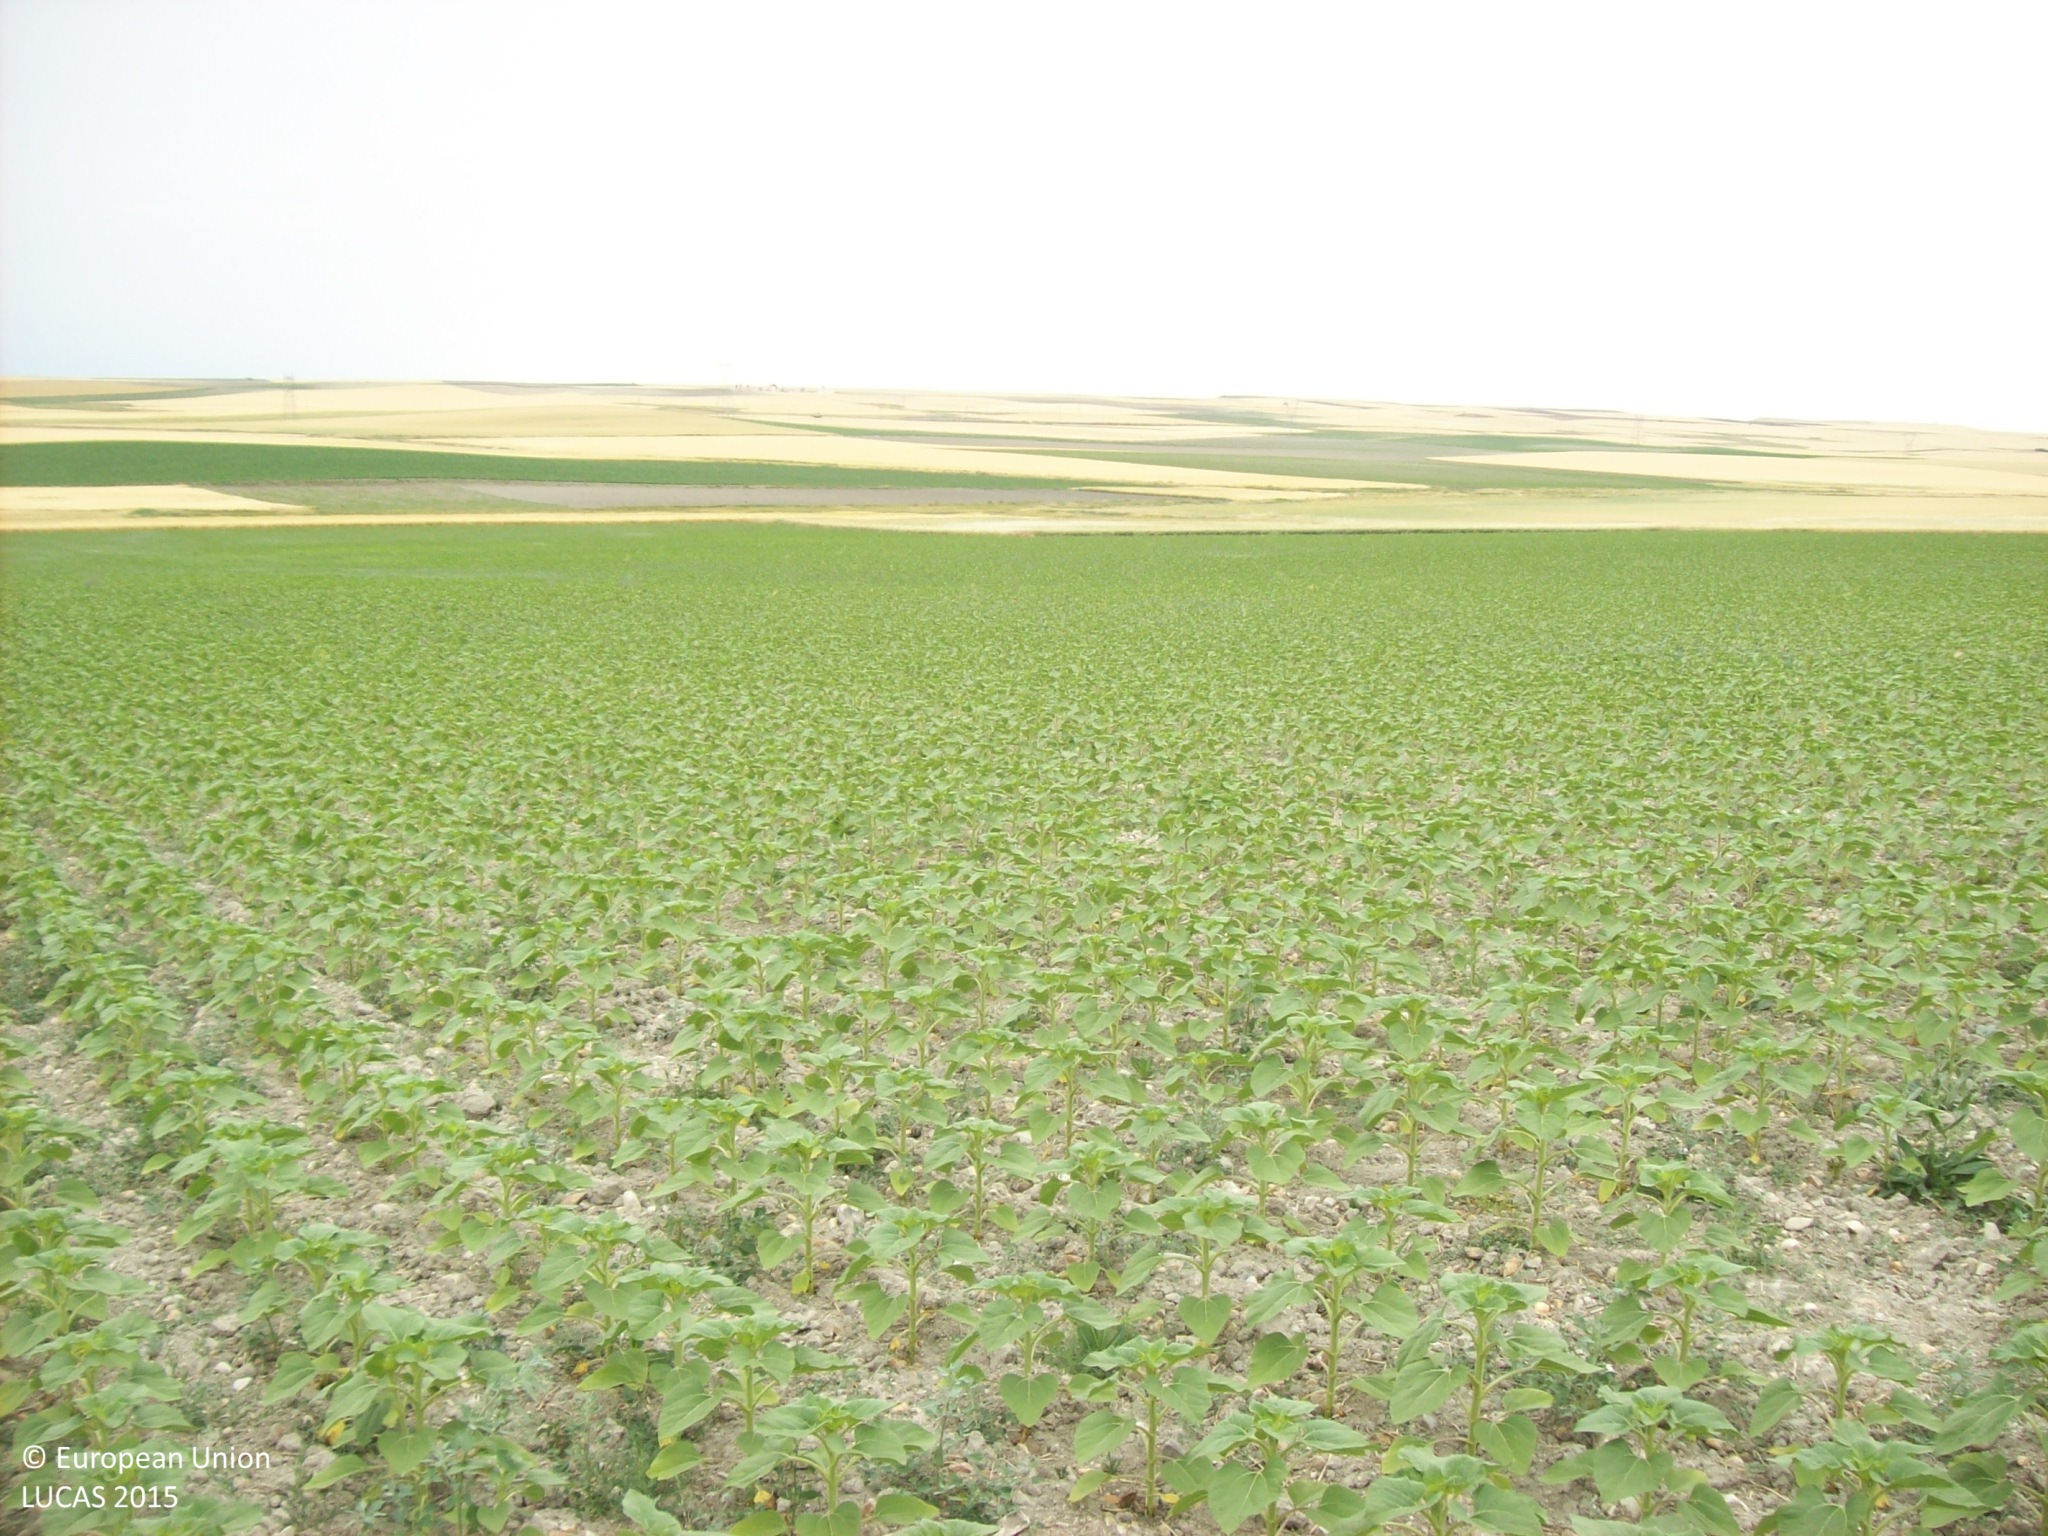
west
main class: Cropland
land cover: Sunflower
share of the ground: > 75 %
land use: Agriculture (excluding fallow land and kitchen gardens)
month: June
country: ES
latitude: 41.1872
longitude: -4.5942
